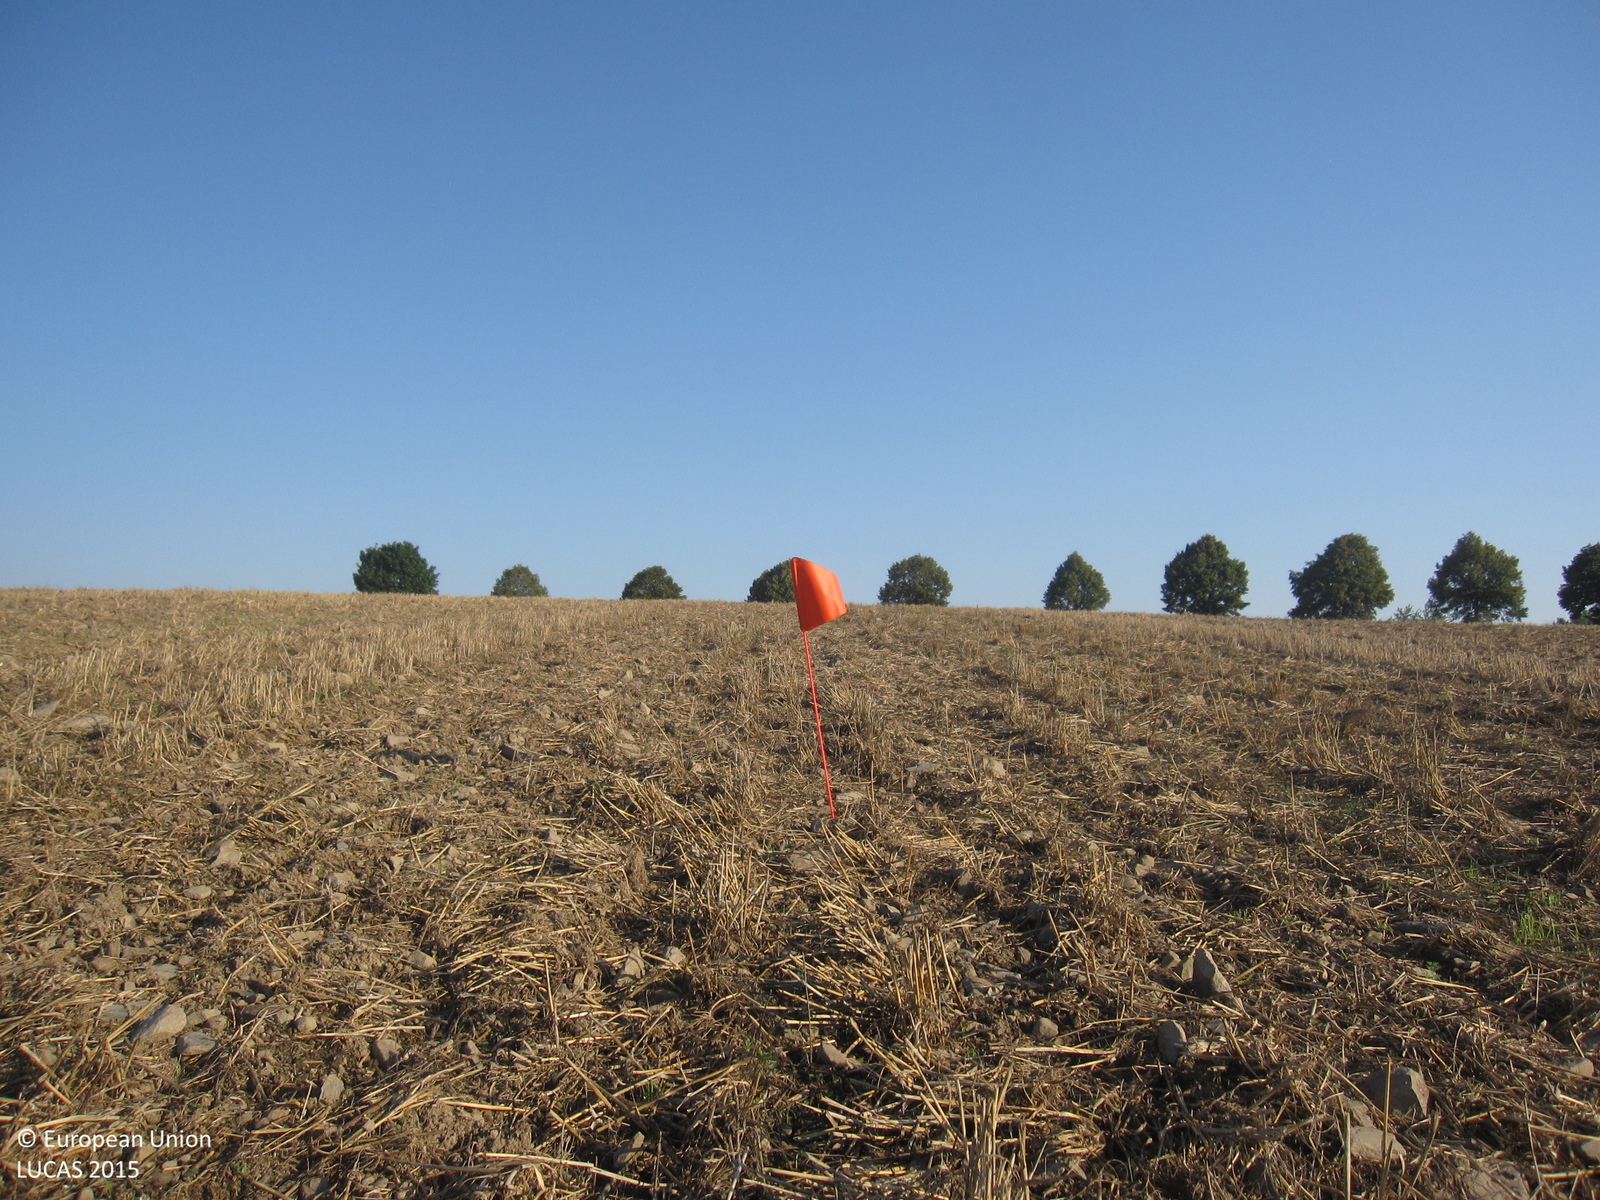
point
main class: Cropland
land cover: Common wheat
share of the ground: 25 - 50 %
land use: Agriculture (excluding fallow land and kitchen gardens)
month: August
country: DE
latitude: 50.5875
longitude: 11.5392
